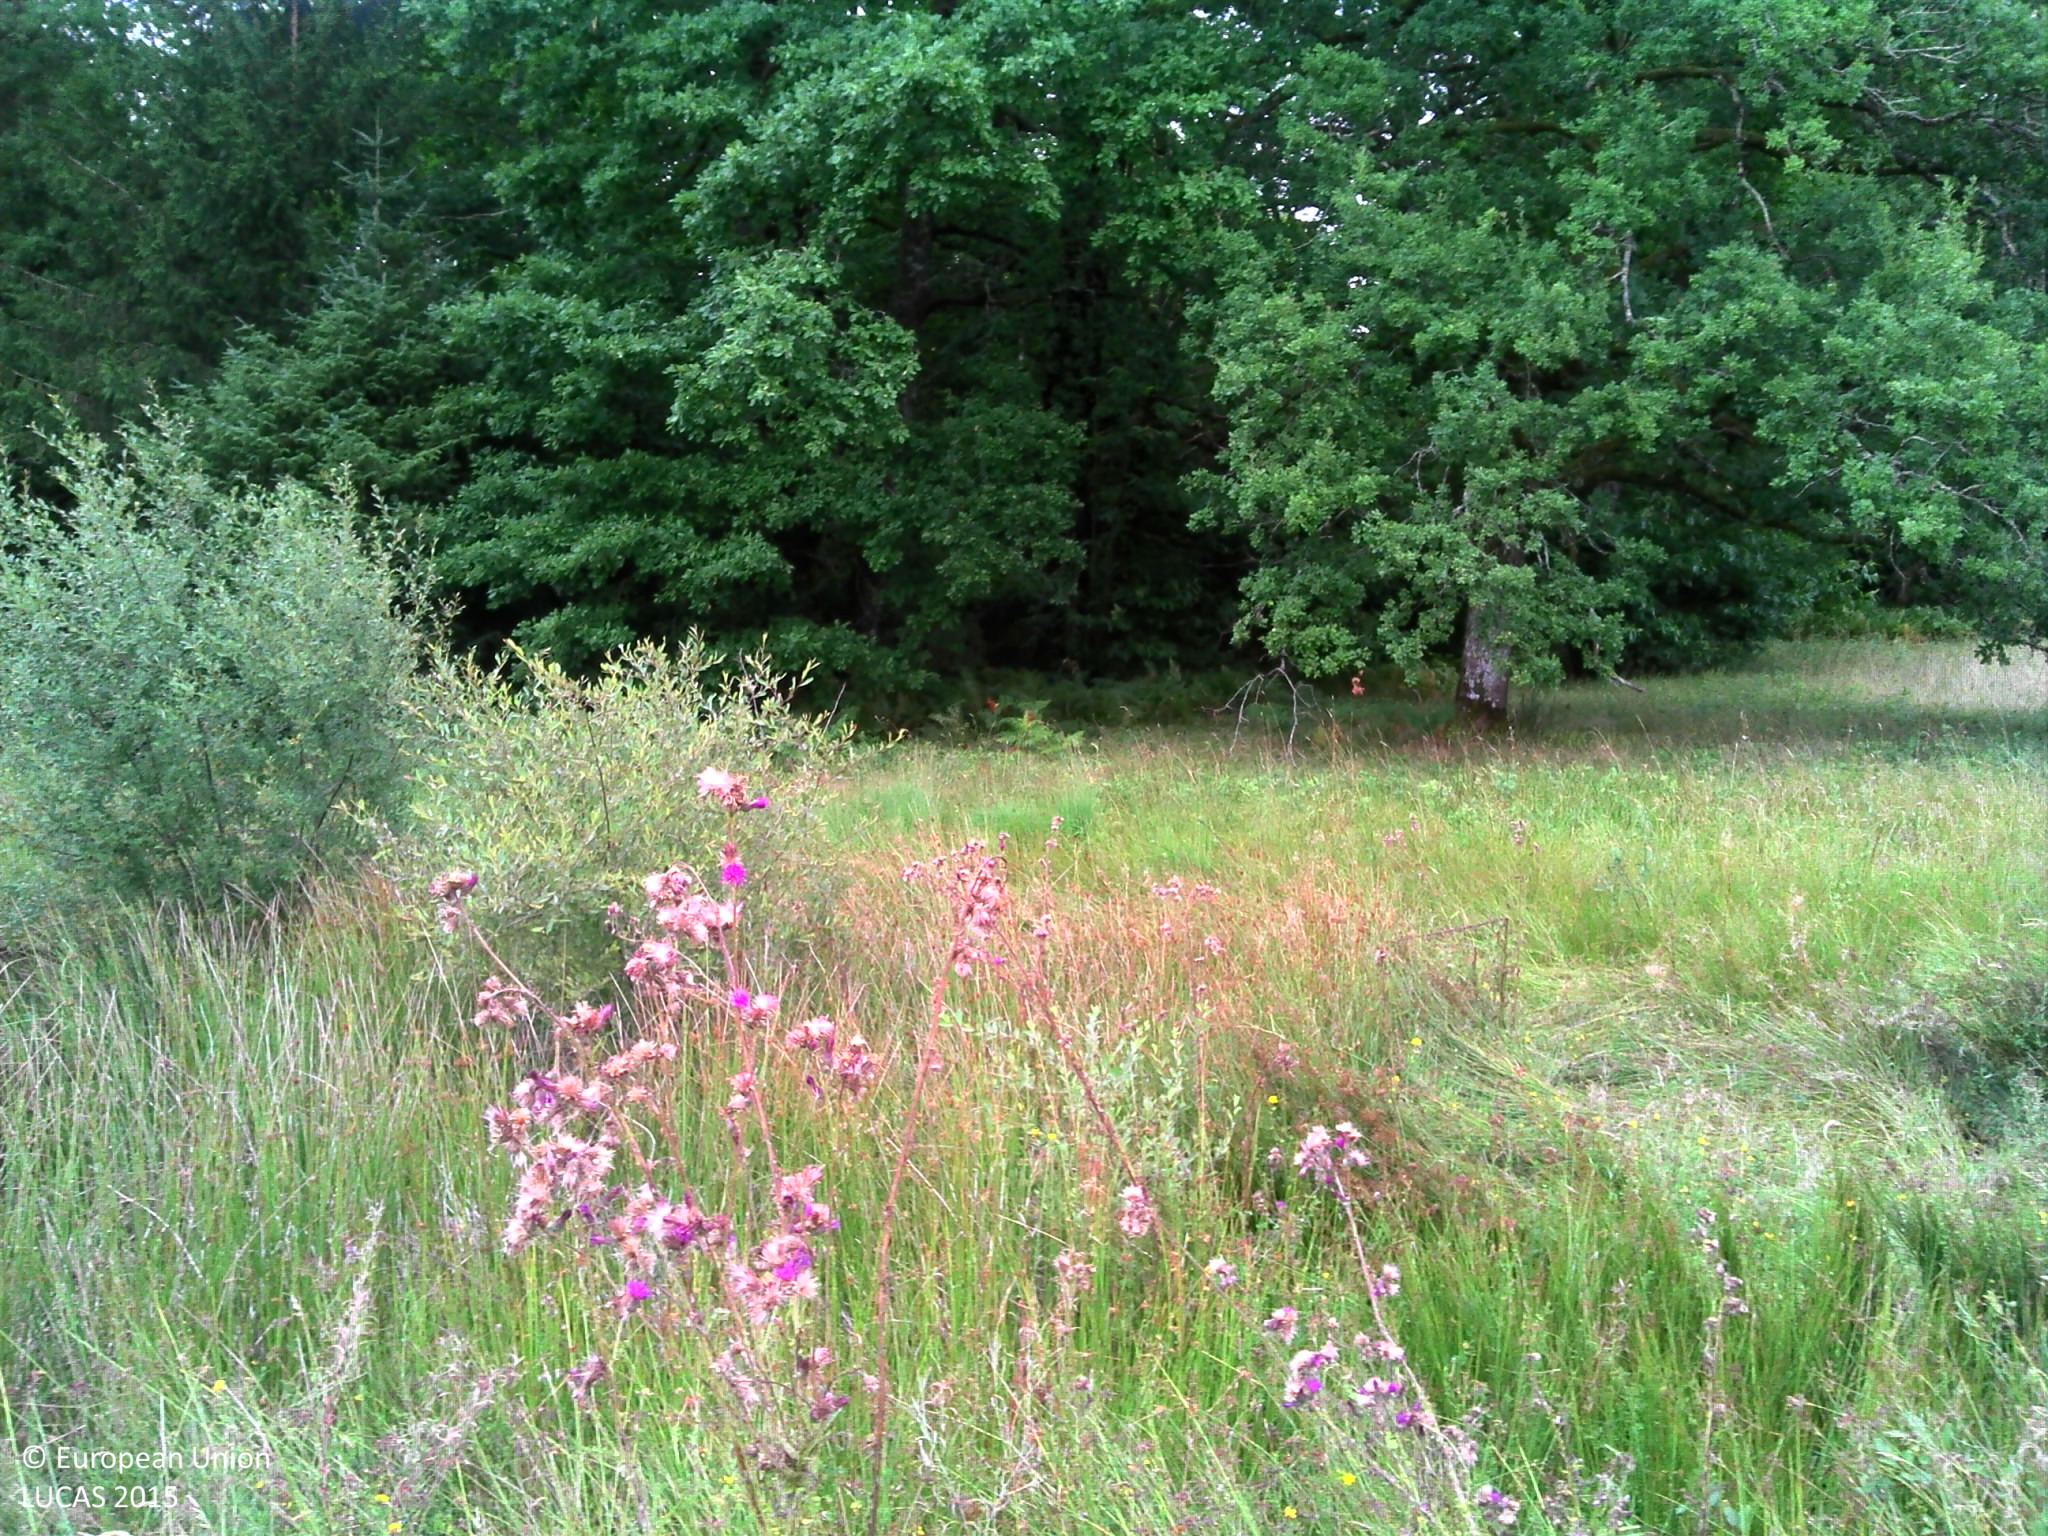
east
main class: Grassland
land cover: Grassland without tree/shrub cover
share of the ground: > 75 %
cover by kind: herbaceous plants 100 %
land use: Agriculture (excluding fallow land and kitchen gardens)
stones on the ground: < 10 %
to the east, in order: Grassland without tree/shrub cover; Inland fresh water bodies; Broadleaved woodland; Shrubland without tree cover; Electric lines; Shrubland without tree cover; Broadleaved woodland; Grass margins; Paved roads, cycling and walking lanes; Grass margins; Tracks
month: July
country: FR
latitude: 45.5645
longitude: 0.6993
